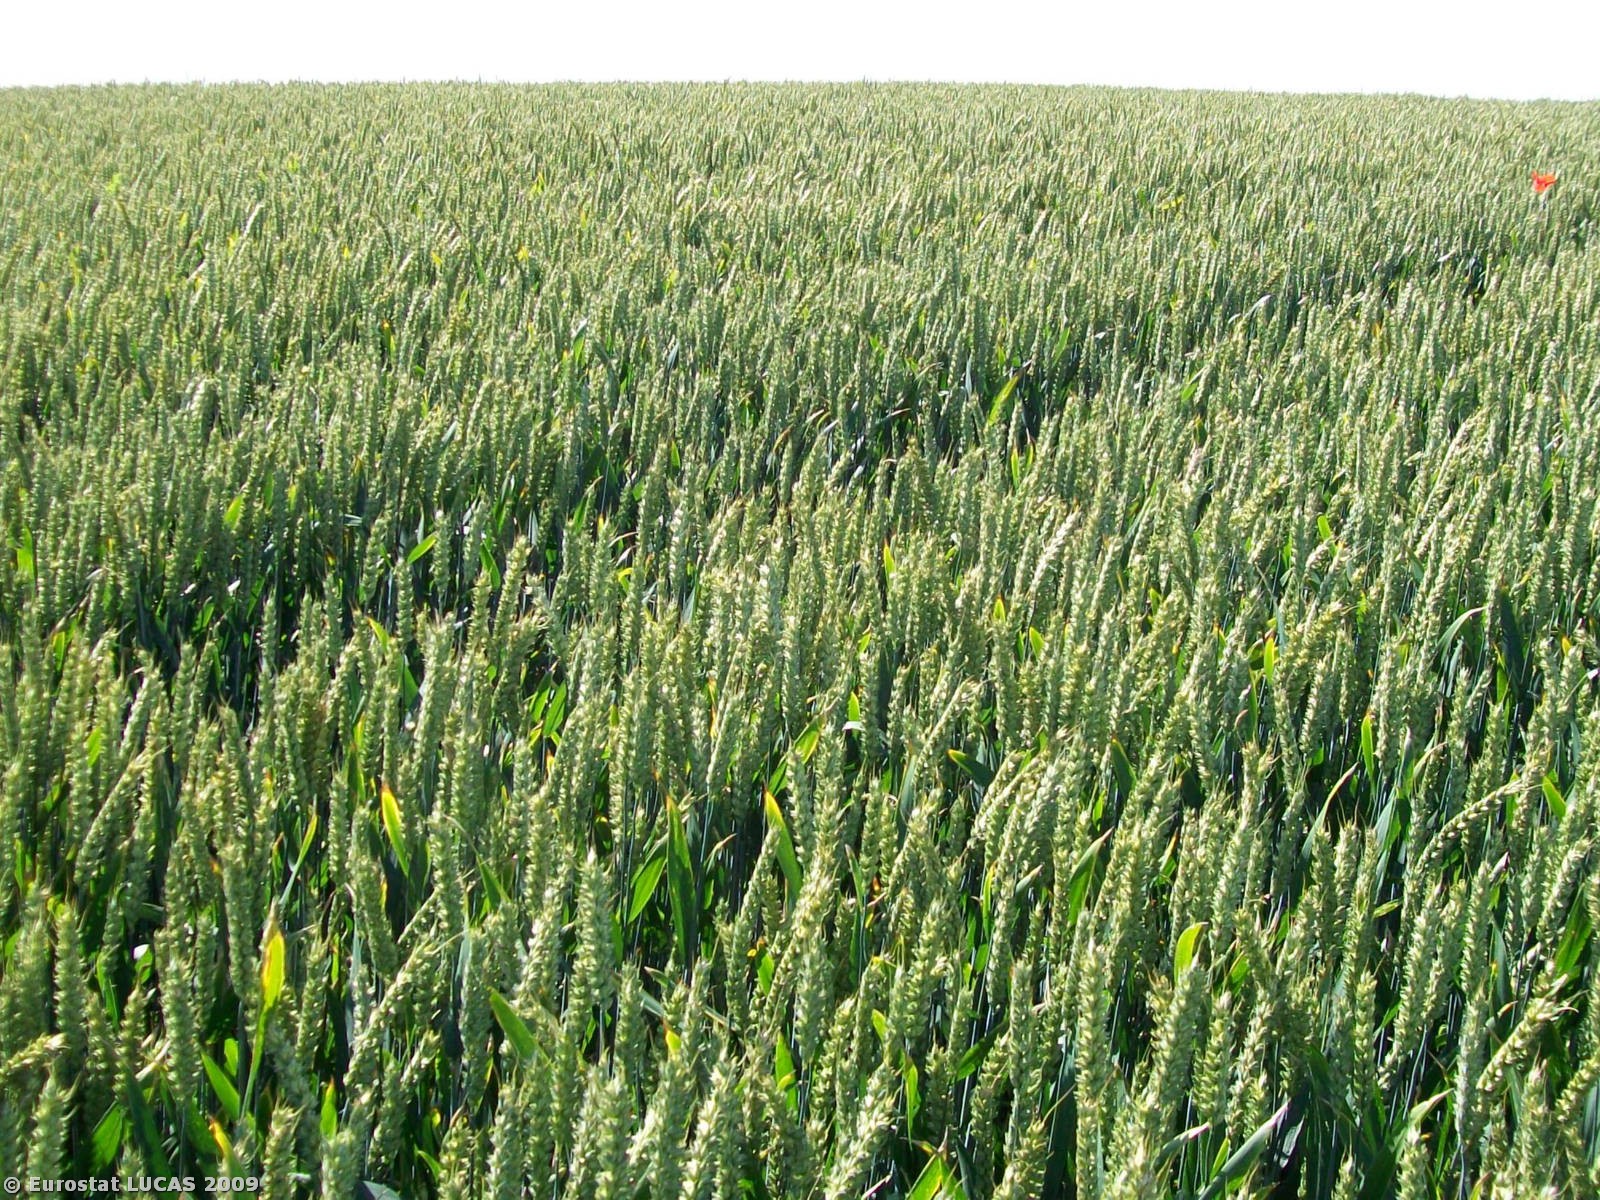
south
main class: Cropland
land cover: Common wheat
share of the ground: > 75 %
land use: Agriculture (excluding fallow land and kitchen gardens)
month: July
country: GB
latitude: 53.6475
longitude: -1.3484
